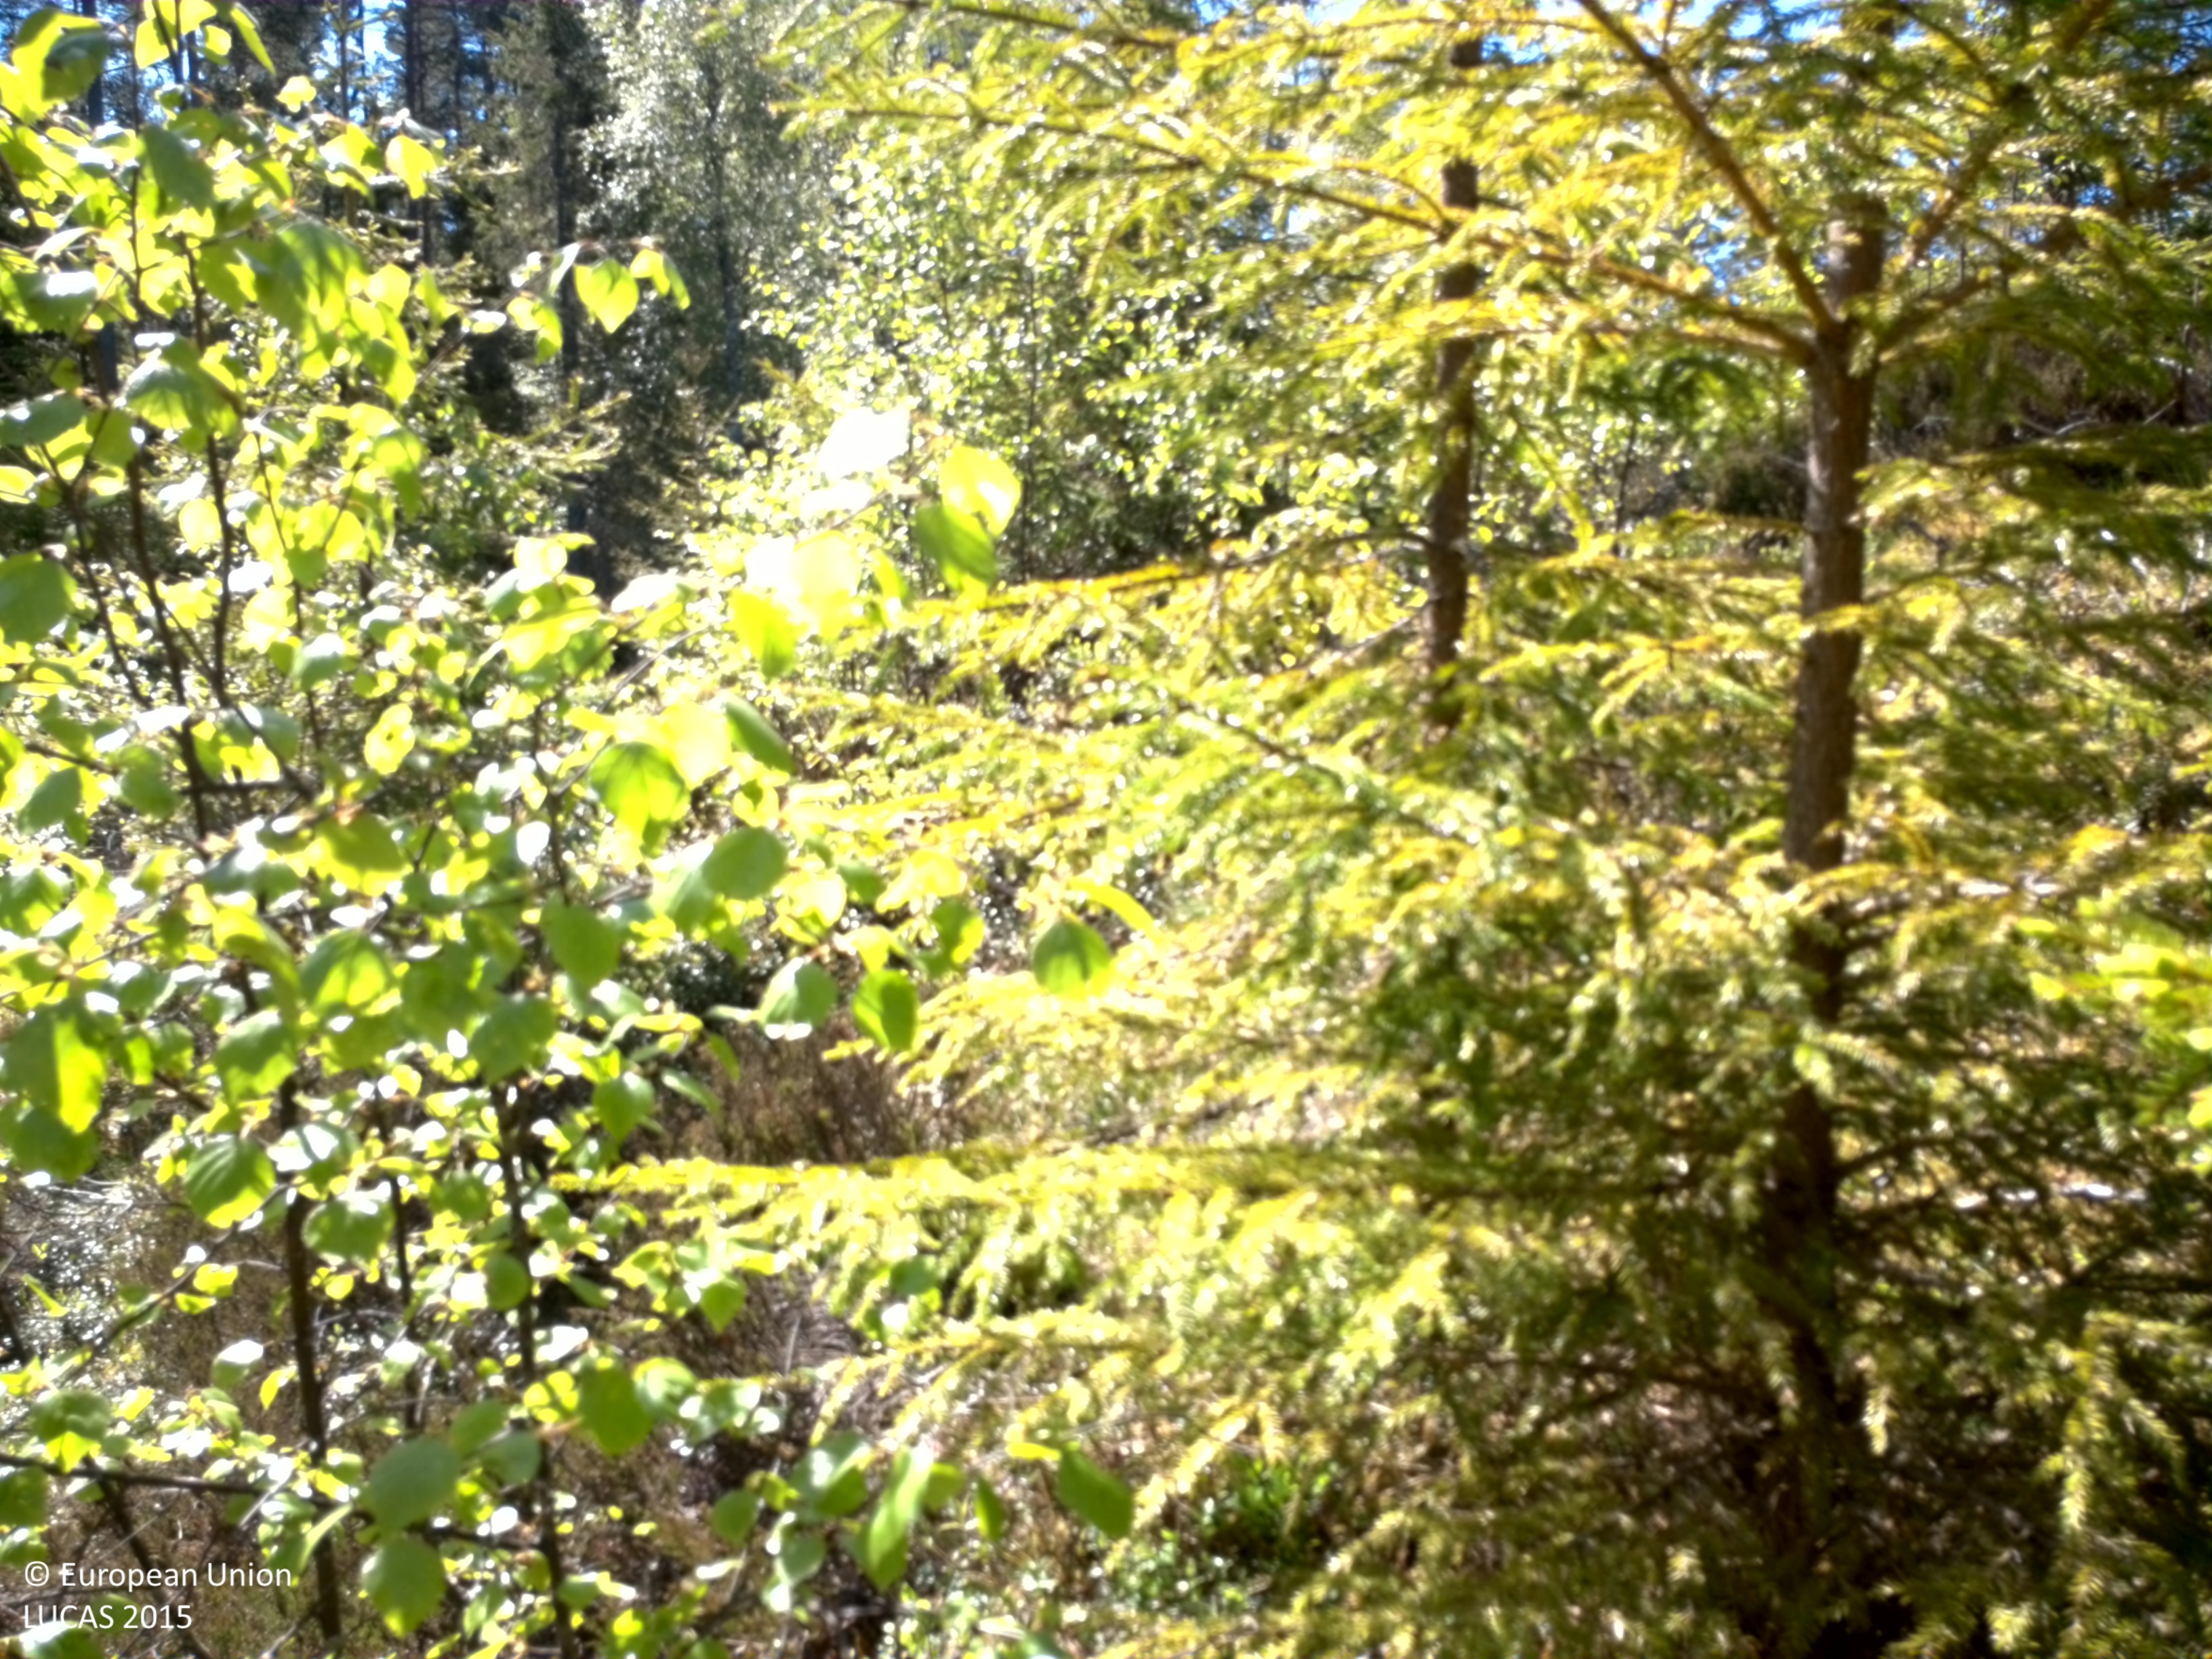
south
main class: Woodland
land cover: Spruce dominated coniferous woodland
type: boreal forest
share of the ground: 50 - 75 %
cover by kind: coniferous forest trees 50 %, shrubs 30 %, lichens and mosses 10 %, broadleaved forest trees 5 %, herbaceous plants 5 %
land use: Forestry
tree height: < 5 m
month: June
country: SE
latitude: 59.4038
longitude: 12.4071
